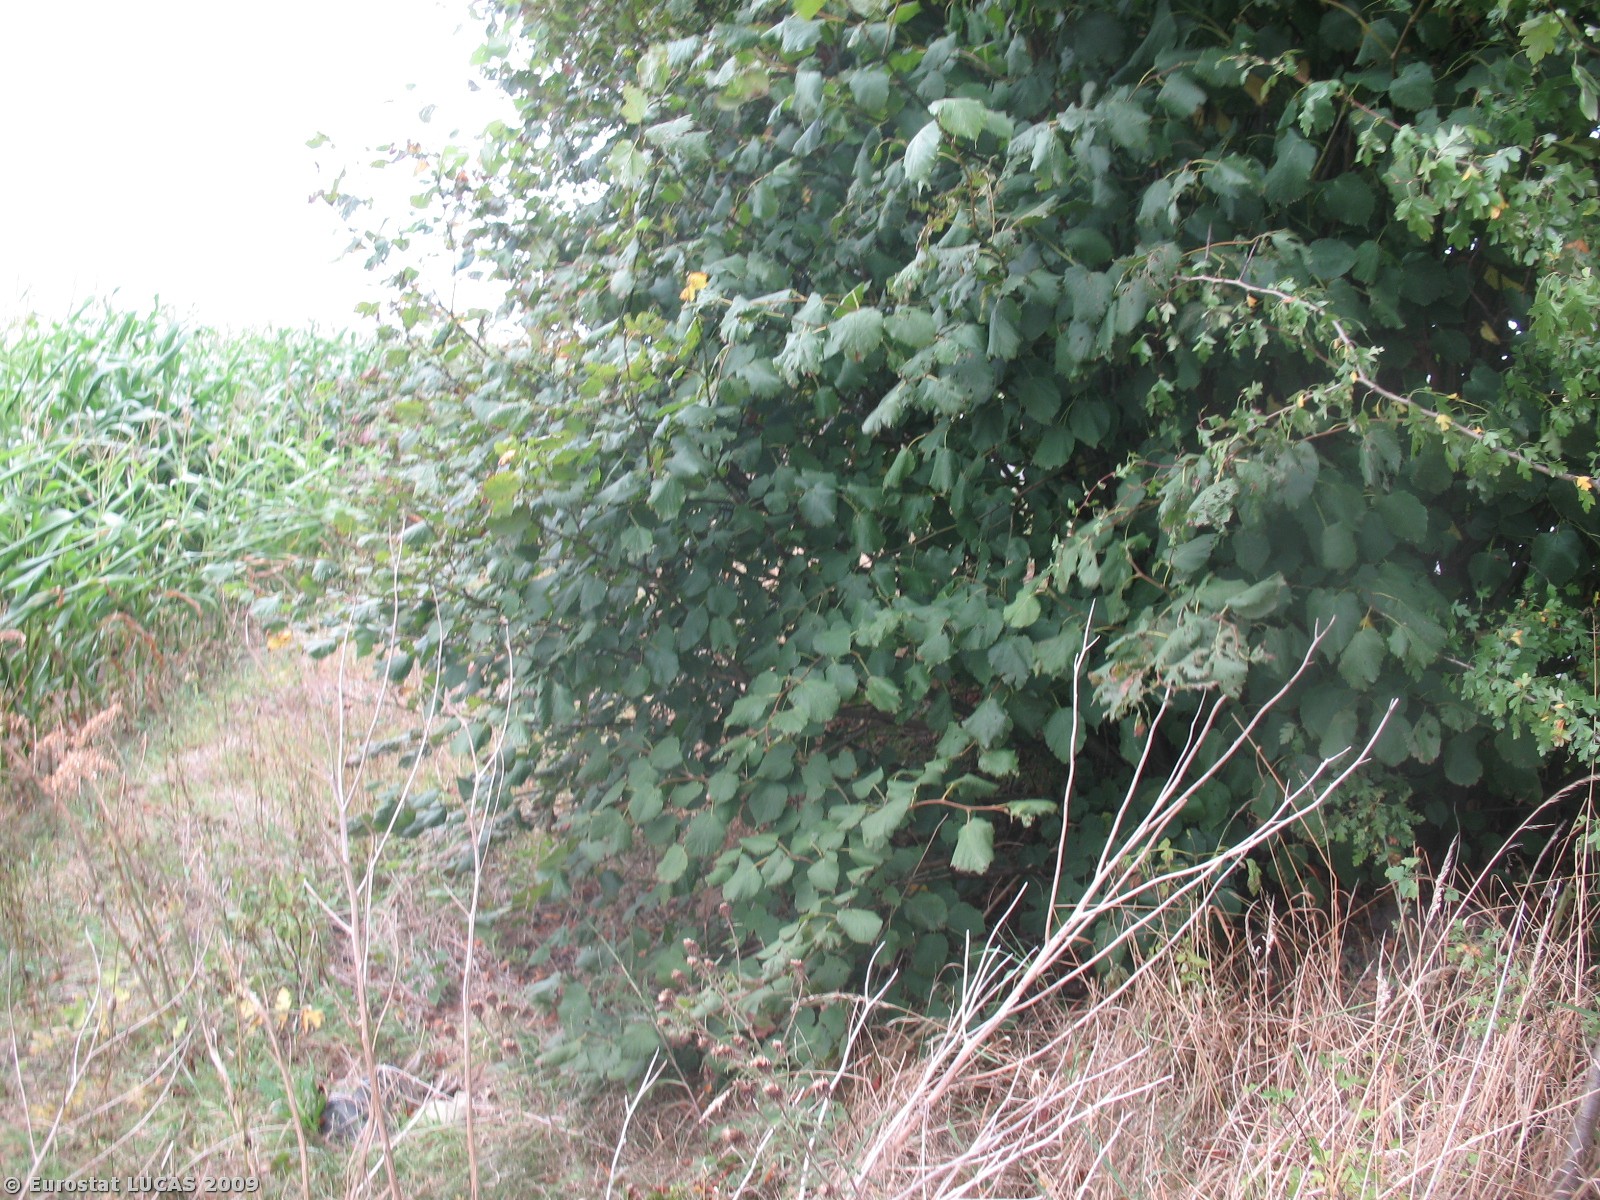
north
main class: Woodland
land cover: Broadleaved woodland
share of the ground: 50 - 75 %
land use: Unused
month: August
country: BE
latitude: 50.4945
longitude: 4.3426
